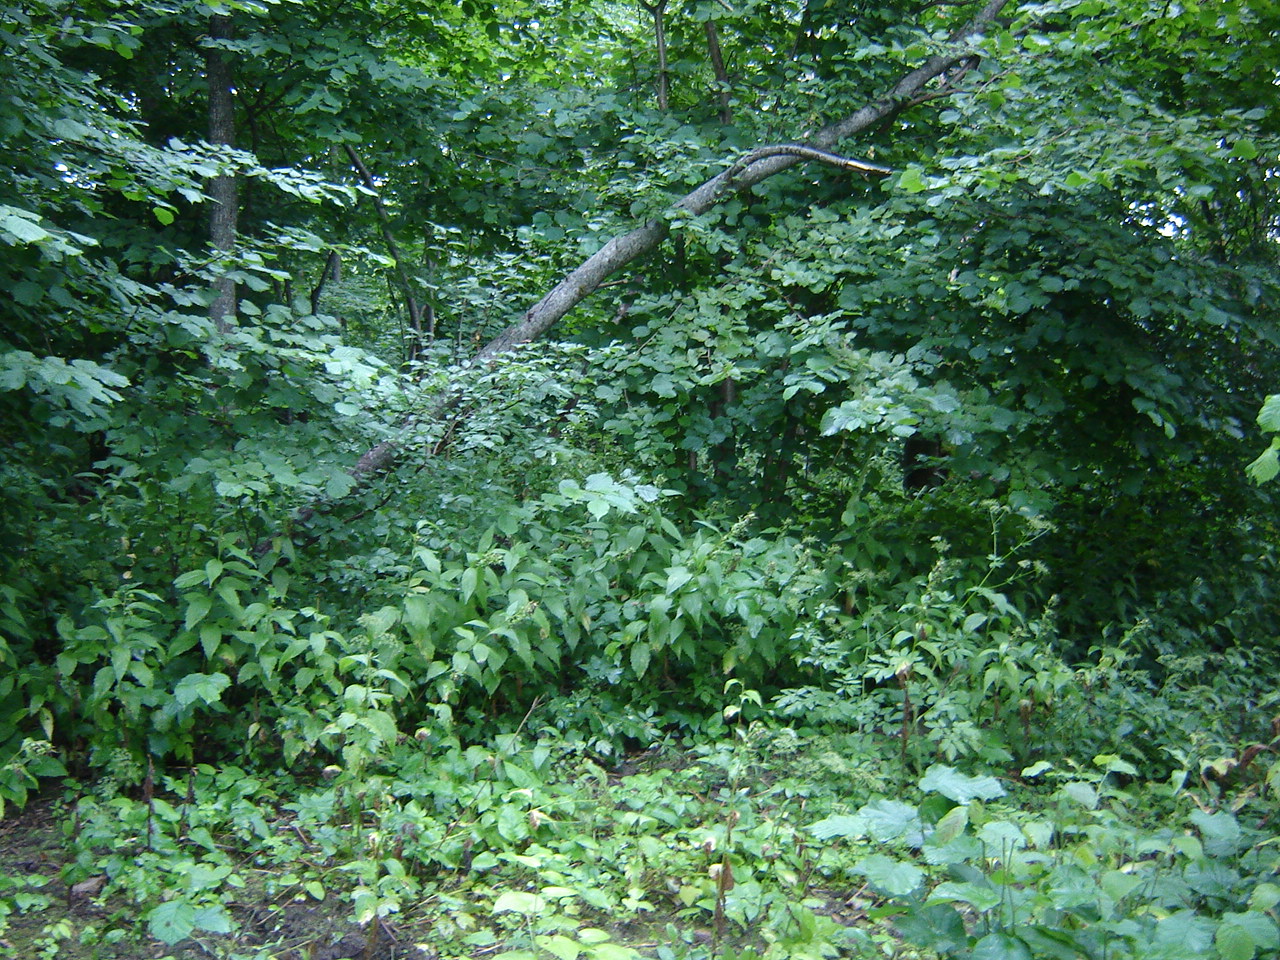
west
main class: Woodland
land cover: Broadleaved woodland
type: floodplain forest
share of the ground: > 75 %
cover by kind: broadleaved forest trees 80 %, herbaceous plants 15 %, shrubs 5 %
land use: Forestry
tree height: > 5 m
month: July
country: LT
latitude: 55.2641
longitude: 24.9834
